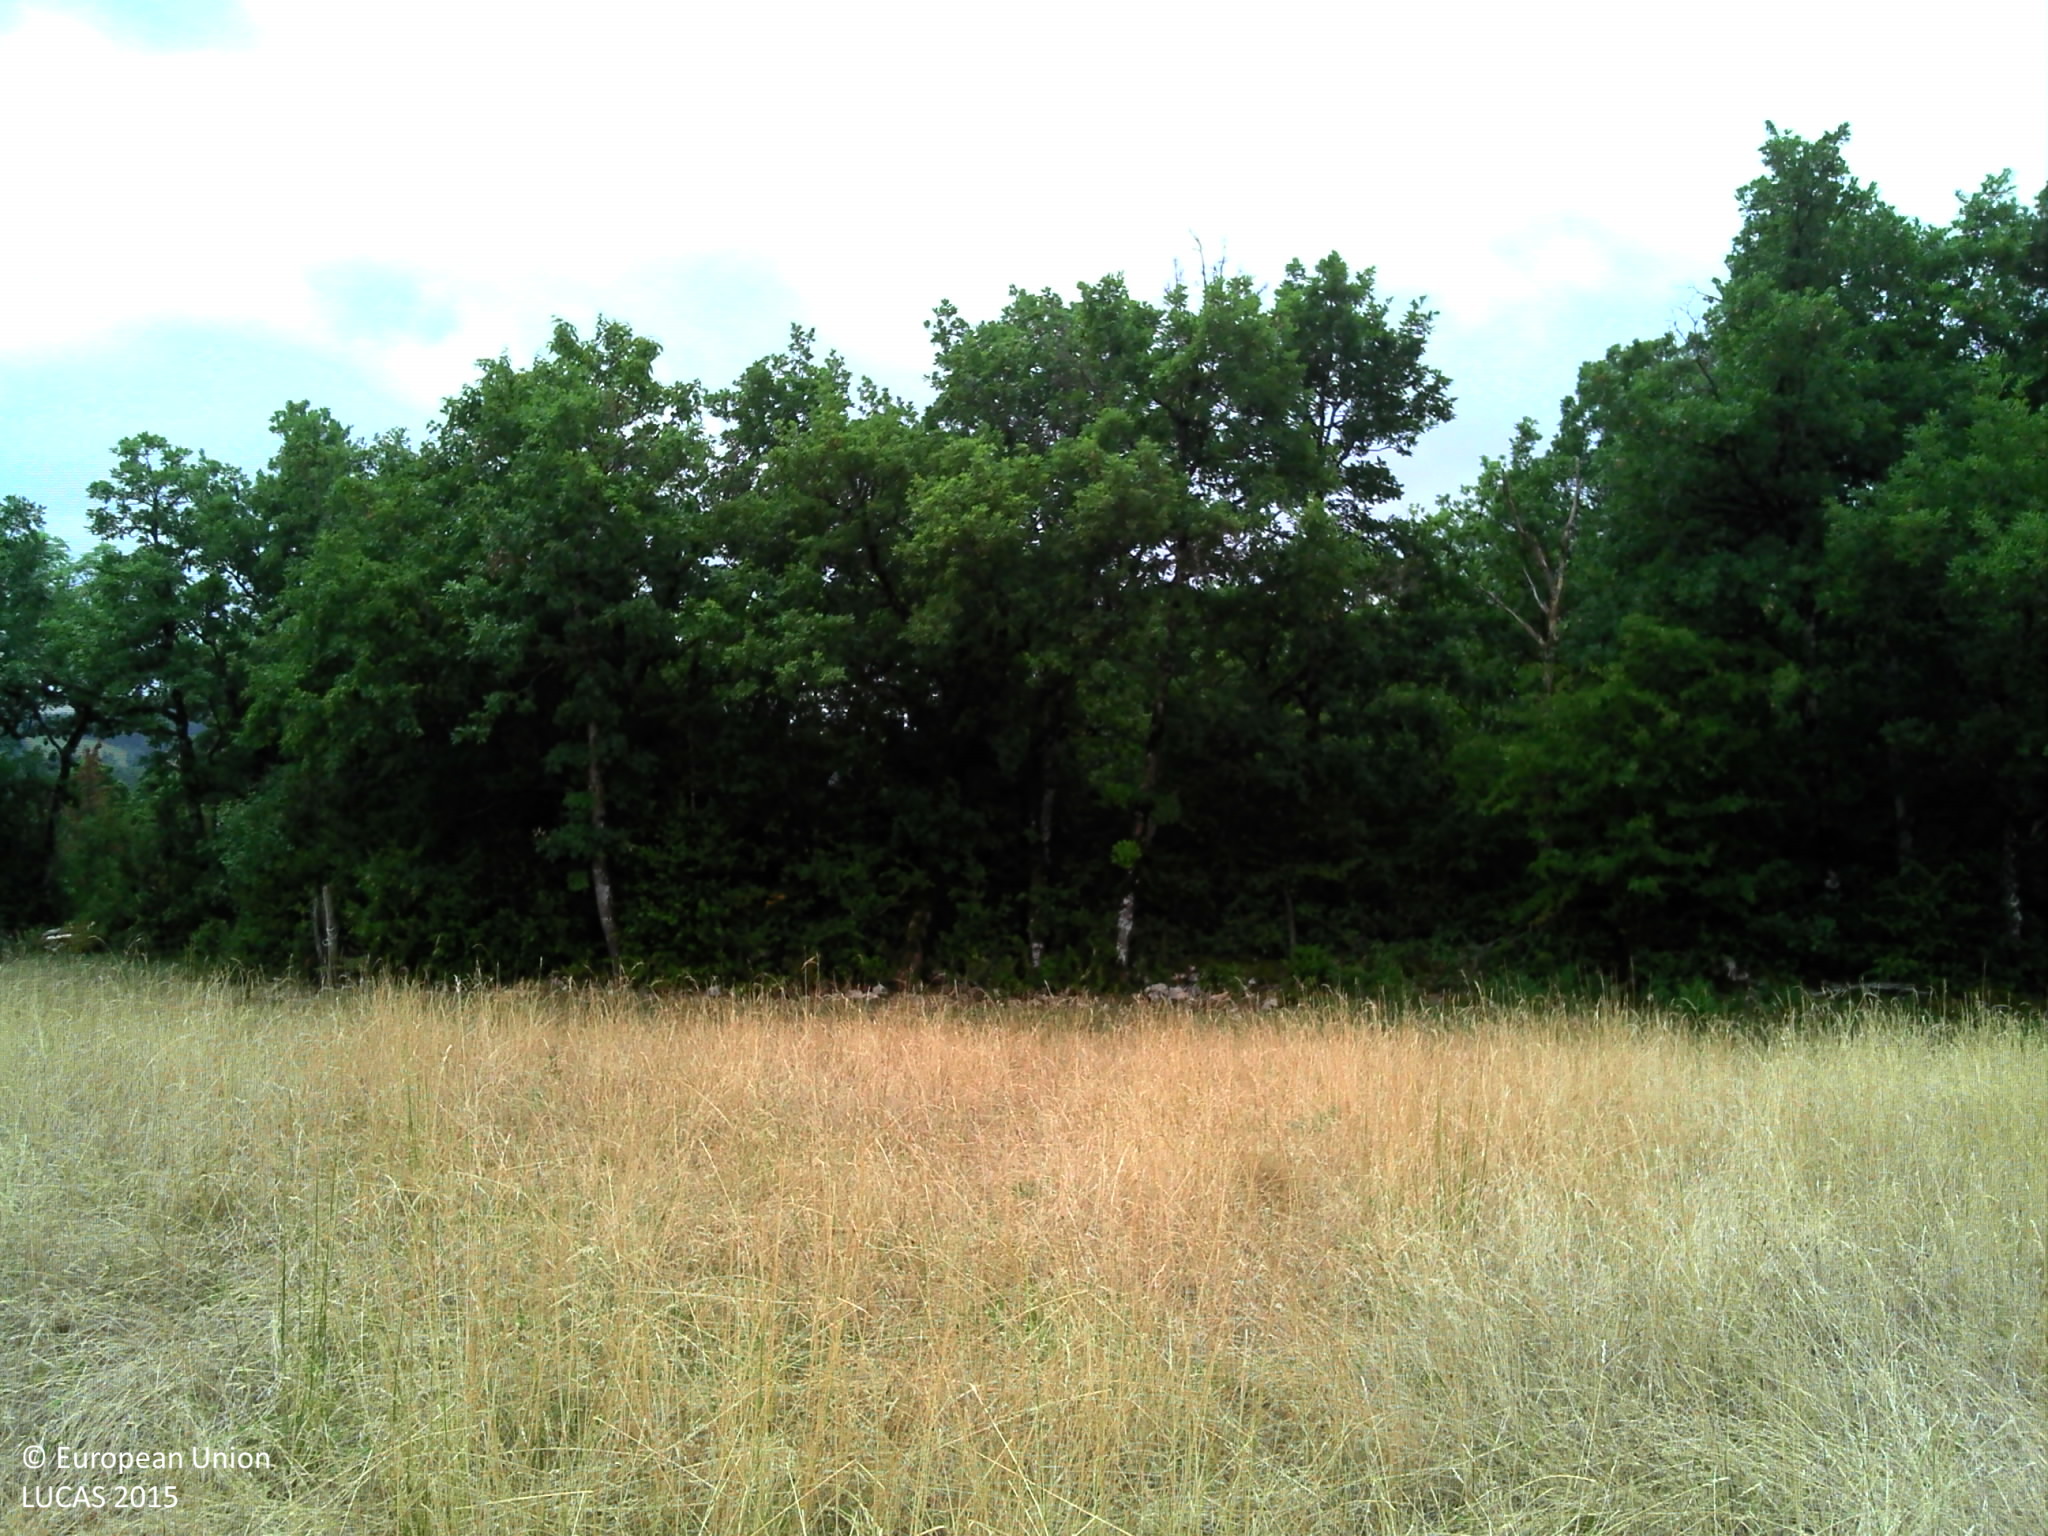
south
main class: Grassland
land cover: Grassland without tree/shrub cover
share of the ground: > 75 %
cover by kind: herbaceous plants 95 %, shrubs 5 %
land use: Agriculture (excluding fallow land and kitchen gardens)
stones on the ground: 25 - 50 %
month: July
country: FR
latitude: 44.4076
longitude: 3.0605
